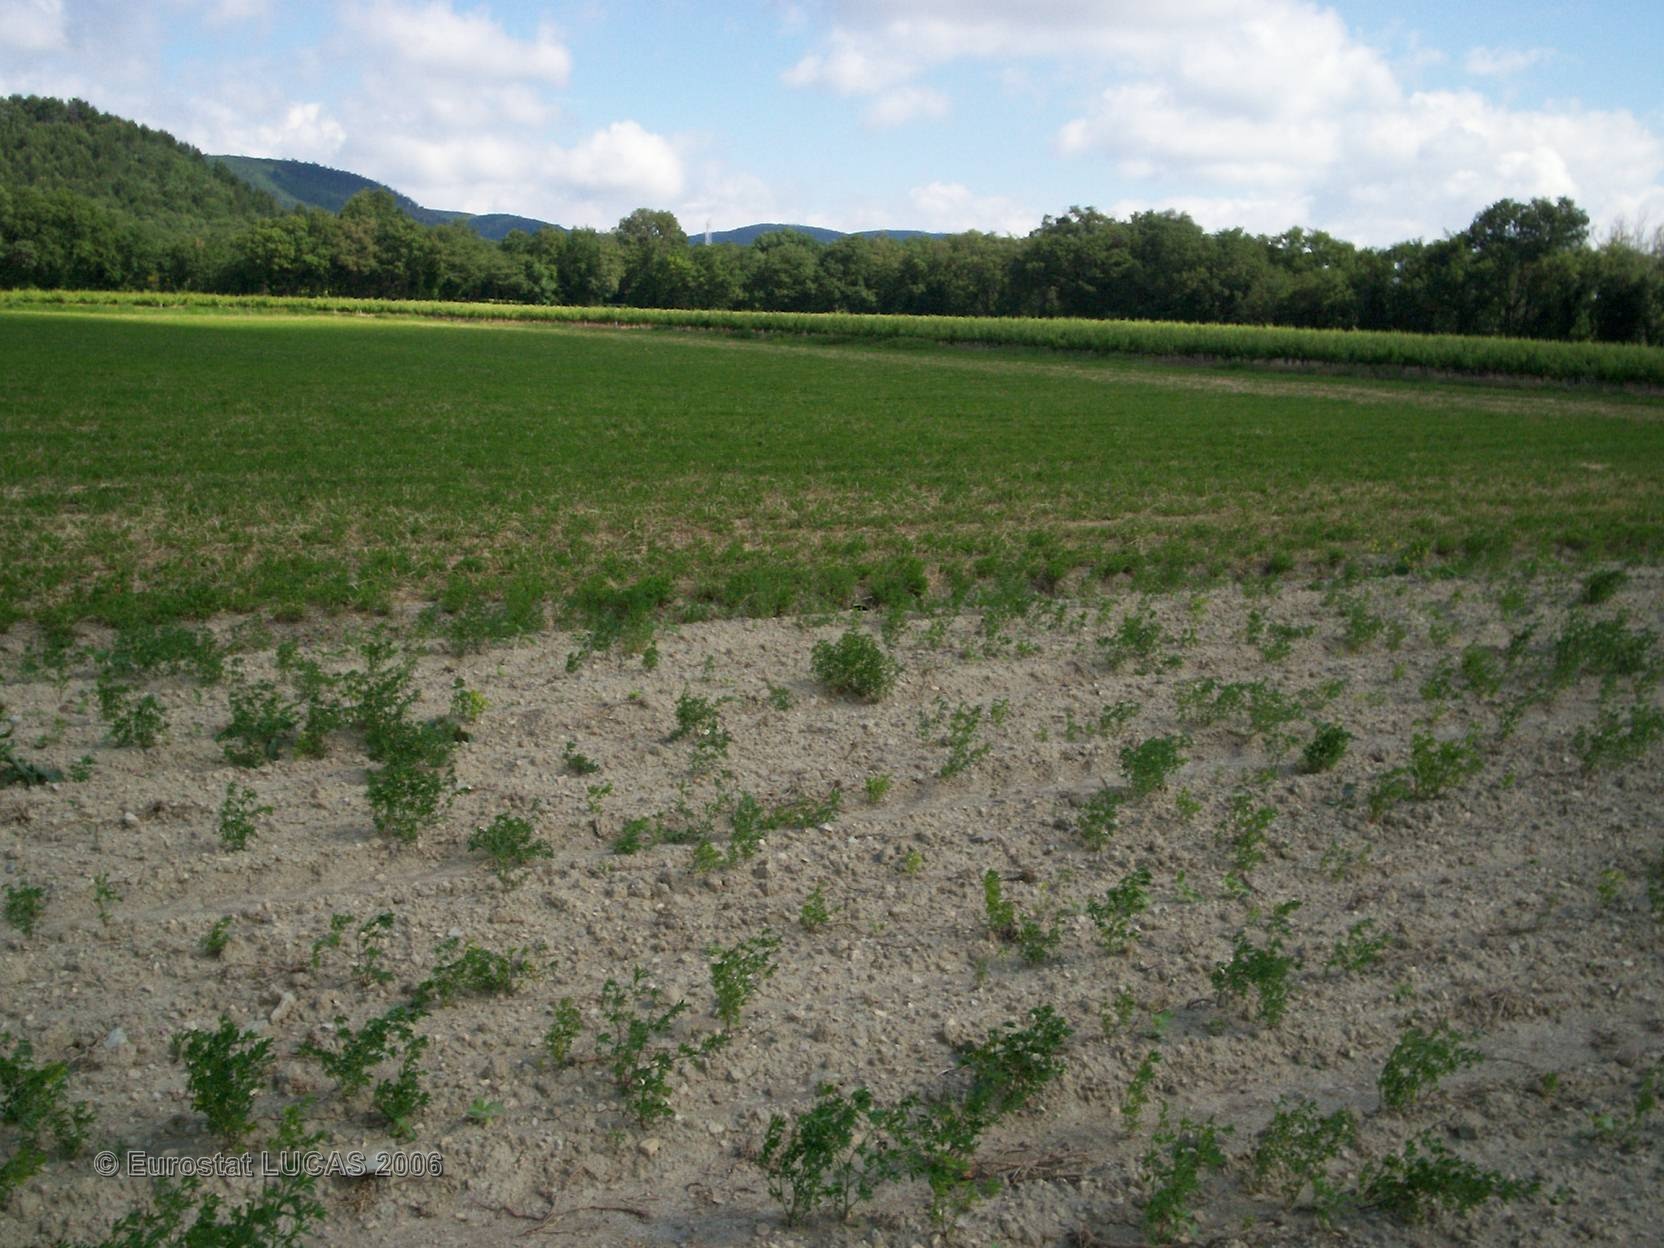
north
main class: Cropland
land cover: Sunflower
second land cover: Lucerne
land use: Agriculture (excluding fallow land and kitchen gardens)
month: May
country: FR
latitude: 44.6215
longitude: 4.8771
